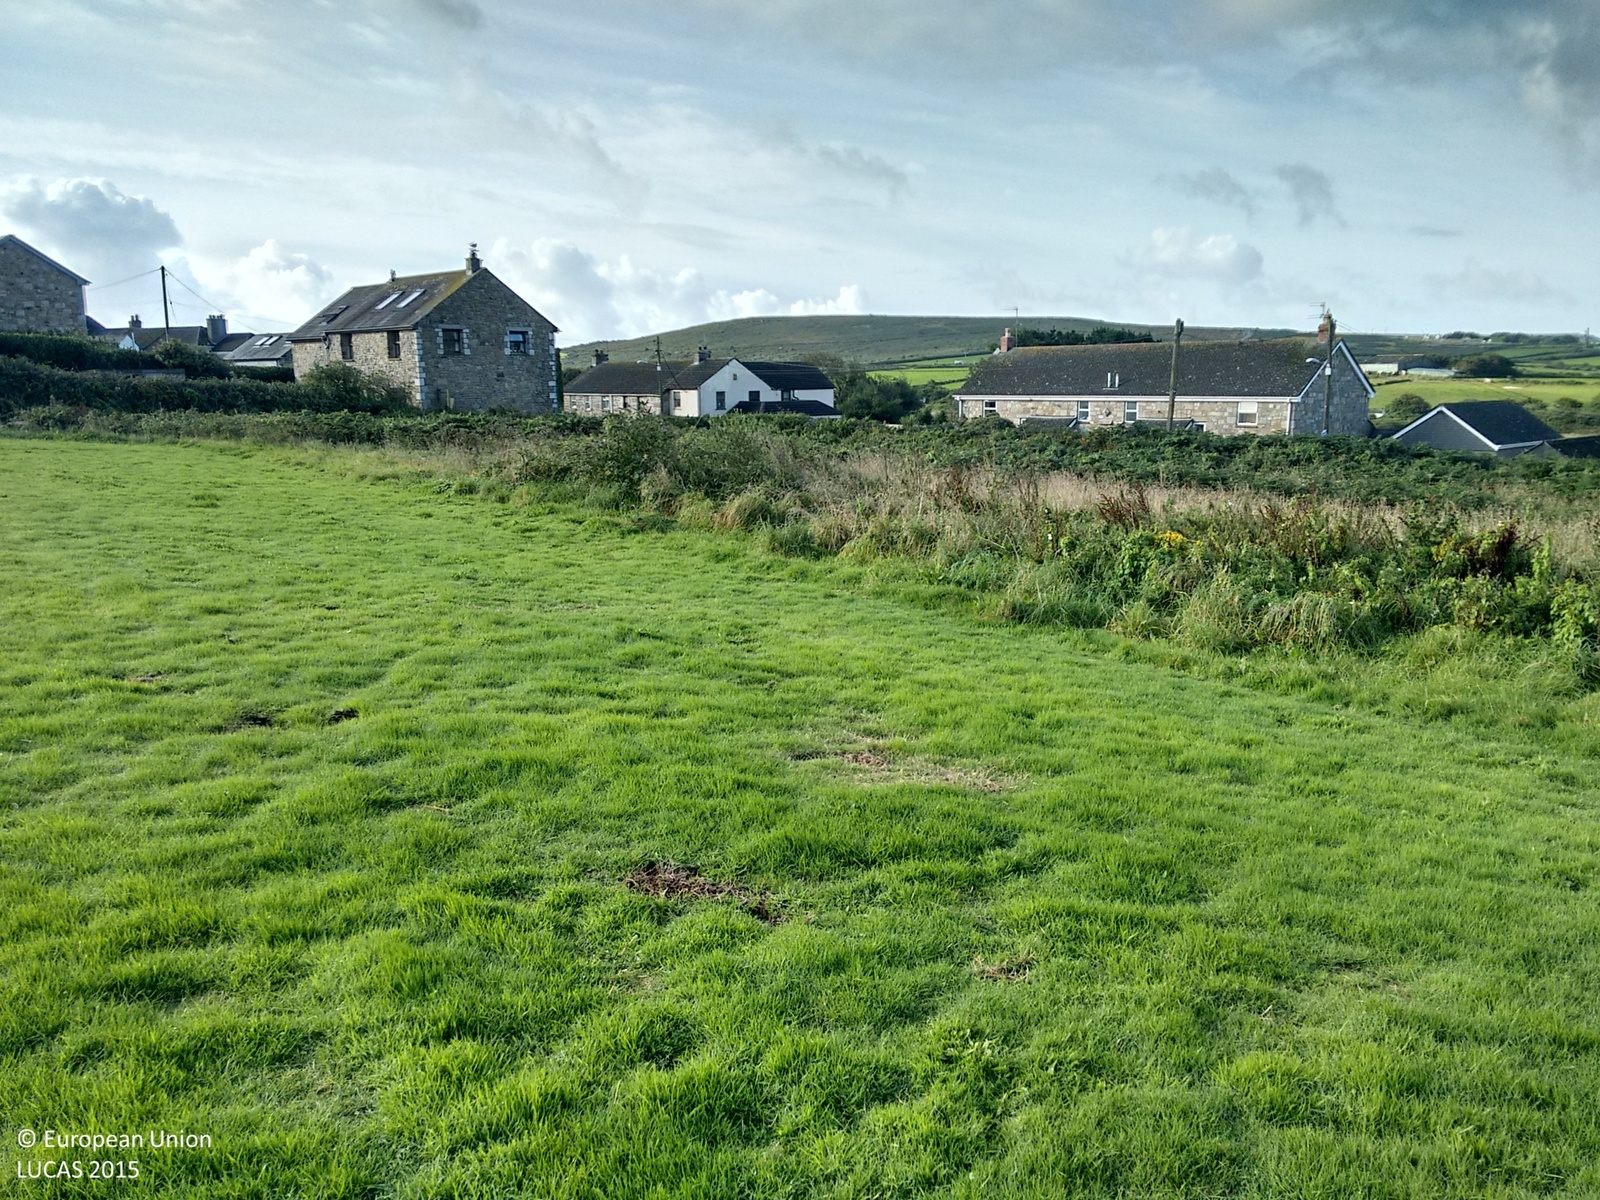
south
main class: Grassland
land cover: Grassland without tree/shrub cover
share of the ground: > 75 %
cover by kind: herbaceous plants 100 %
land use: Sport
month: August
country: GB
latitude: 50.1970
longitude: -5.4950
